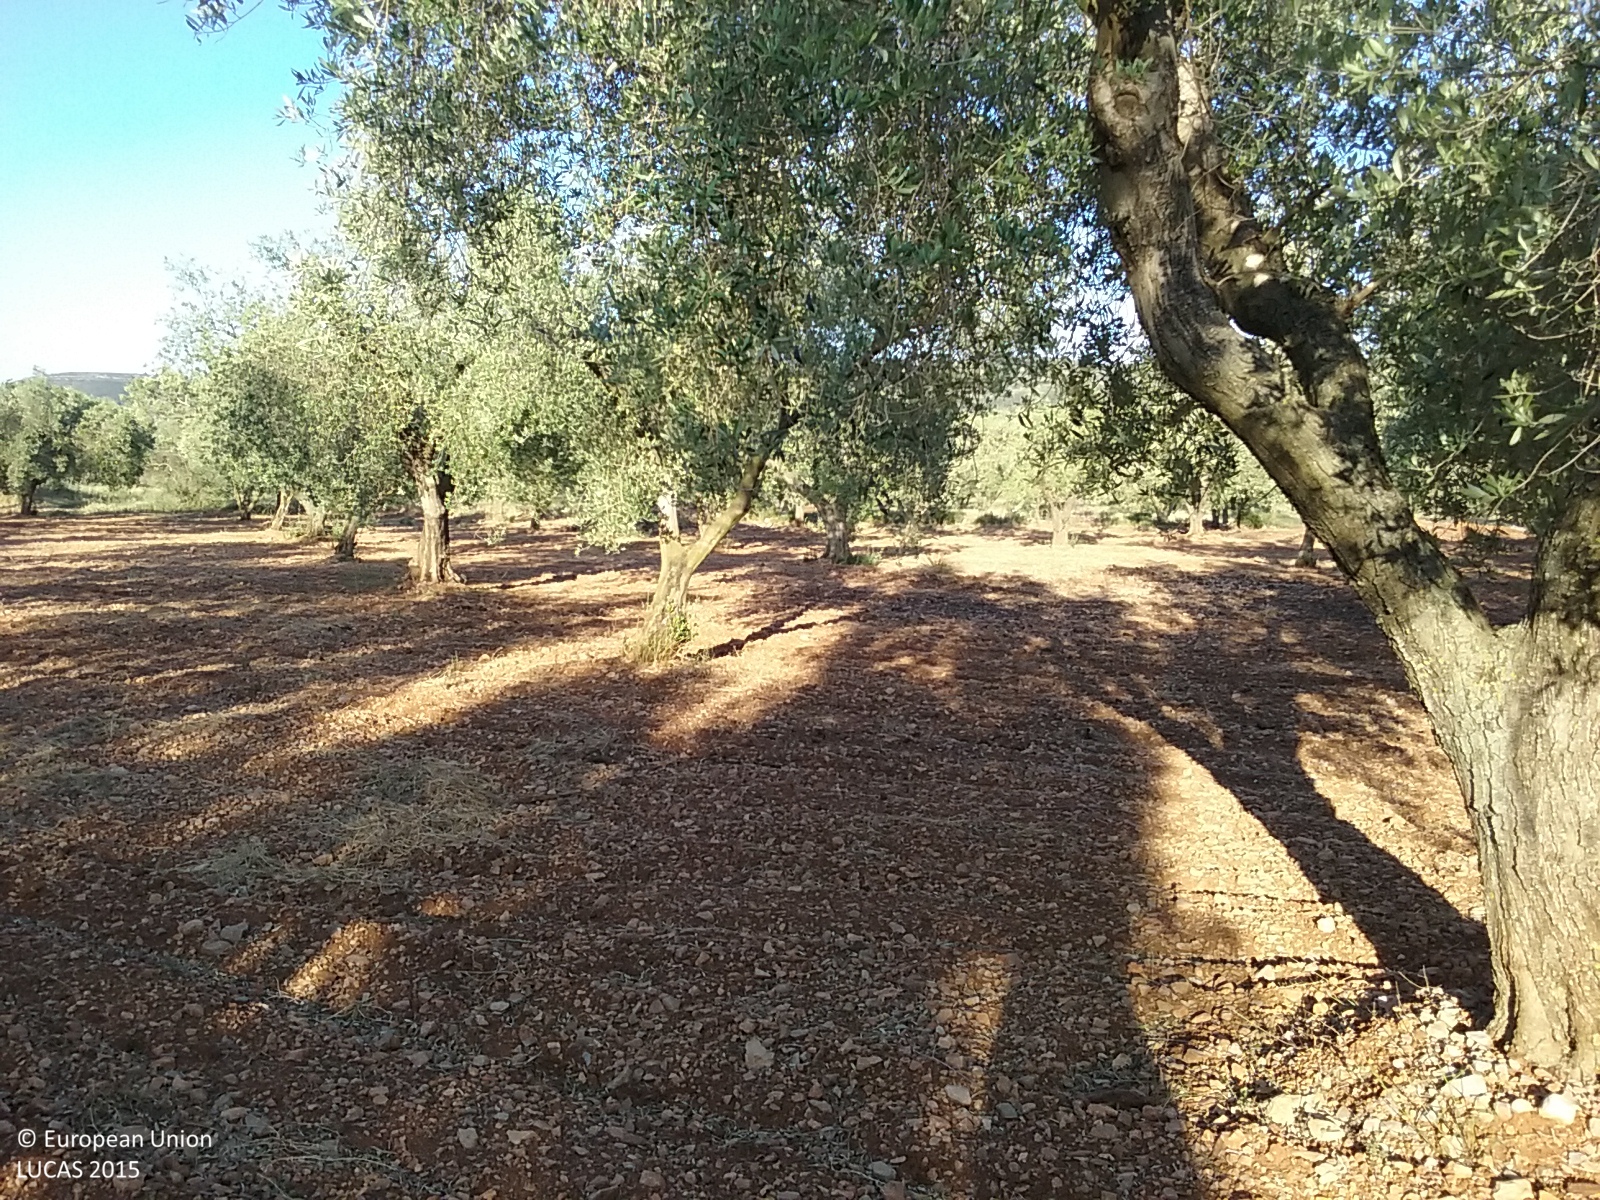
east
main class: Cropland
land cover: Olive groves
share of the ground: 50 - 75 %
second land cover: Other bare soil
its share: > 75 %
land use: Agriculture (excluding fallow land and kitchen gardens)
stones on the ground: 25 - 50 %
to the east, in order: Olive groves; Other bare soil; Grass margins; Dry stone walls; Olive groves; Grass margins; Tracks; Olive groves; Nuts trees; Tracks; Grass margins; Olive groves
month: May
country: ES
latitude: 40.4171
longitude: 0.0604
